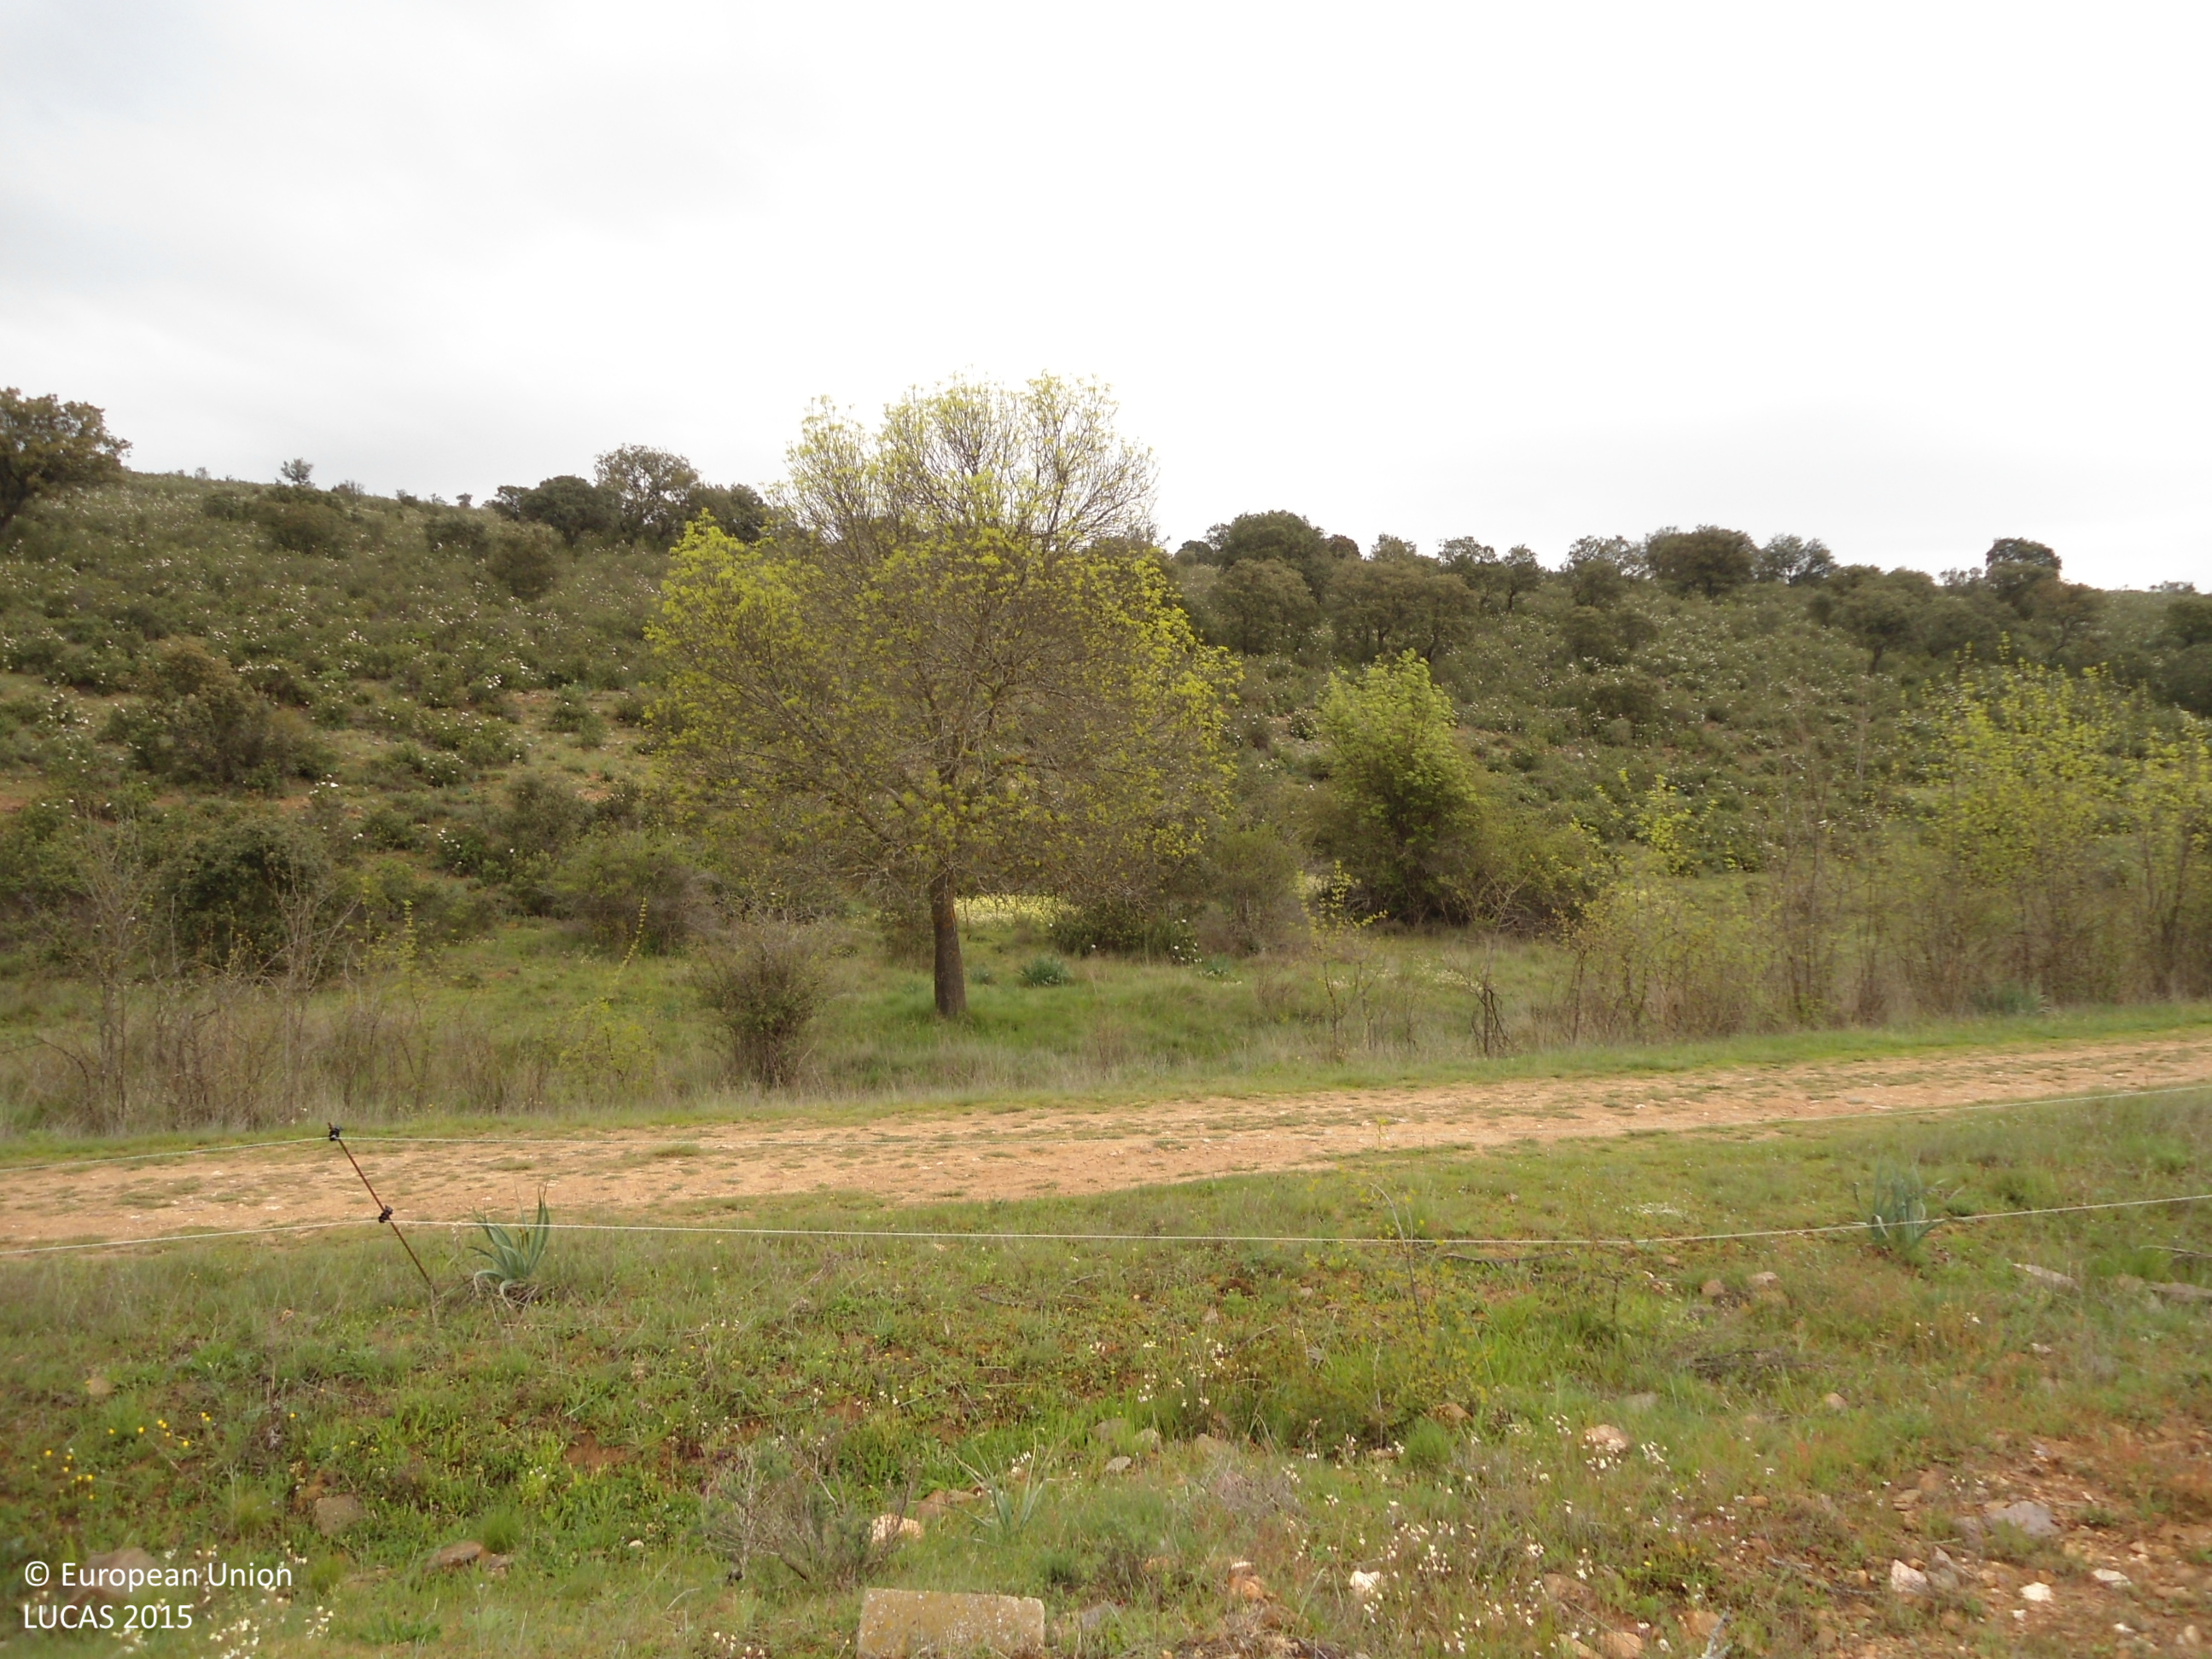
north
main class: Grassland
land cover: Grassland with sparse tree/shrub cover
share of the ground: > 75 %
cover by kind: herbaceous plants 90 %, broadleaved forest trees 5 %, shrubs 5 %
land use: Agriculture (excluding fallow land and kitchen gardens)
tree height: < 5 m
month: April
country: ES
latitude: 41.7409
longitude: -5.8802
